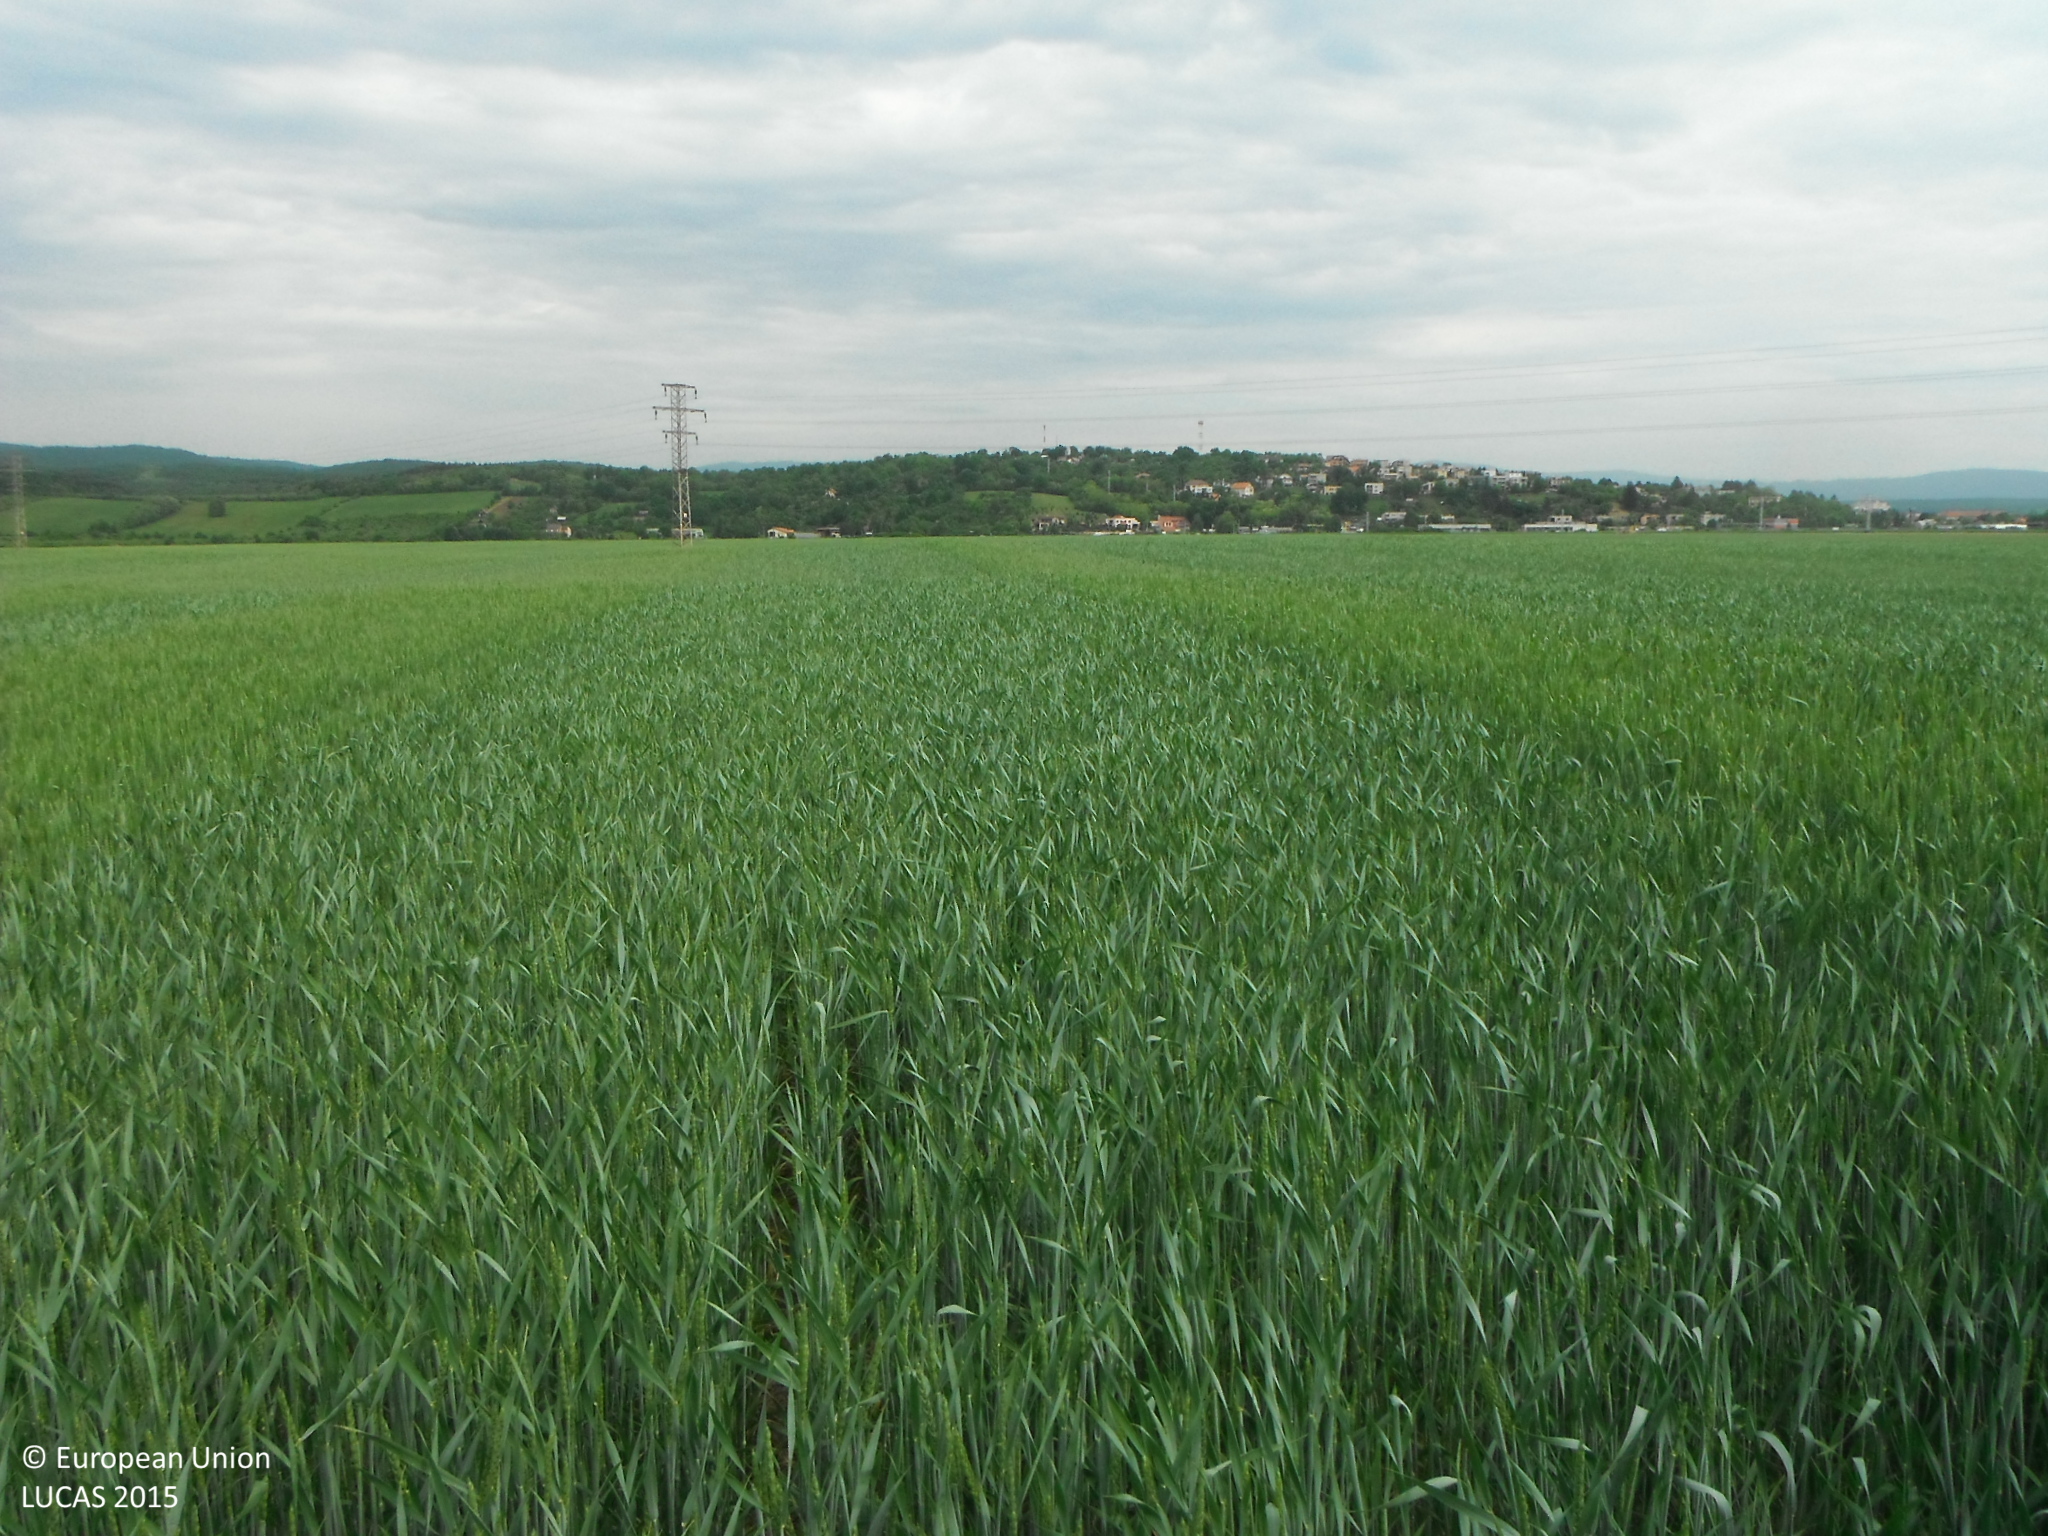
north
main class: Cropland
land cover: Common wheat
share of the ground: > 75 %
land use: Agriculture (excluding fallow land and kitchen gardens)
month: May
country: SK
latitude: 48.5989
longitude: 20.9838
